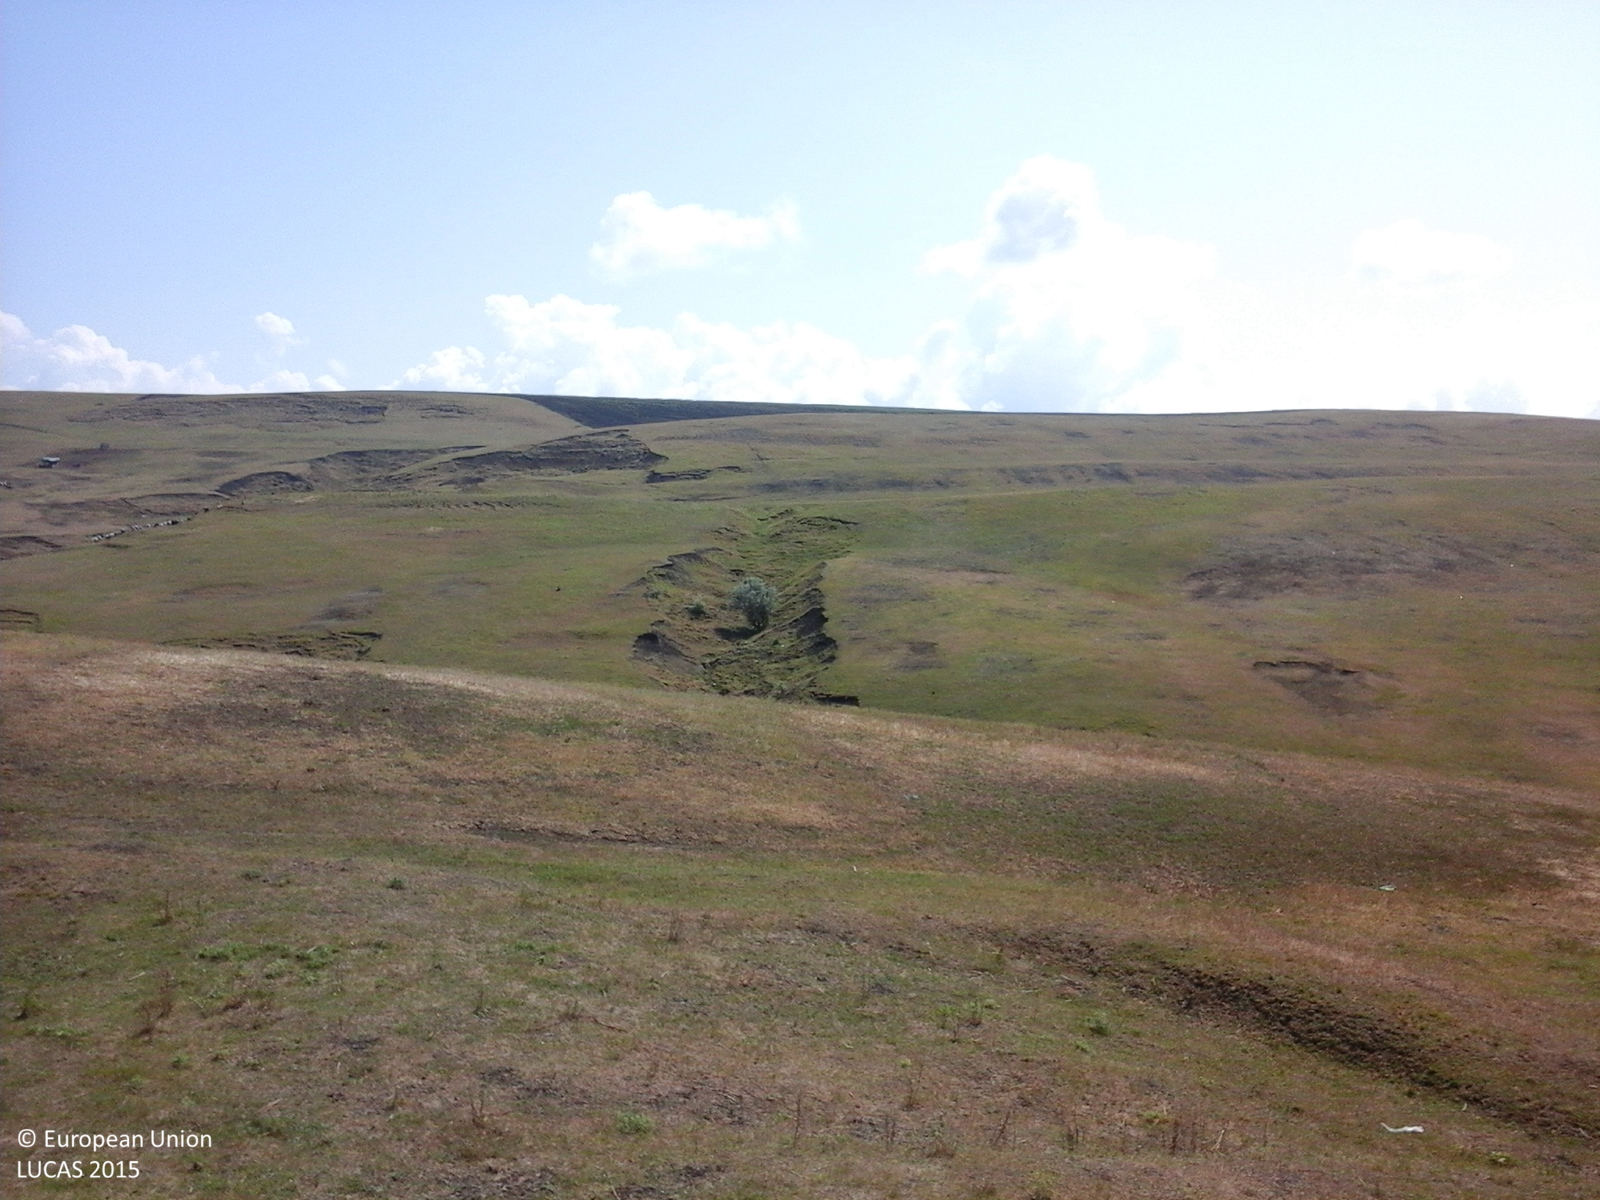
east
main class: Grassland
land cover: Grassland without tree/shrub cover
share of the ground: > 75 %
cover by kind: herbaceous plants 90 %, unconsolidated bare surface 10 %
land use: Agriculture (excluding fallow land and kitchen gardens)
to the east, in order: Grassland without tree/shrub cover; Ditches and canals; Grassland without tree/shrub cover
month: June
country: RO
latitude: 47.9461
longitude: 26.7131
